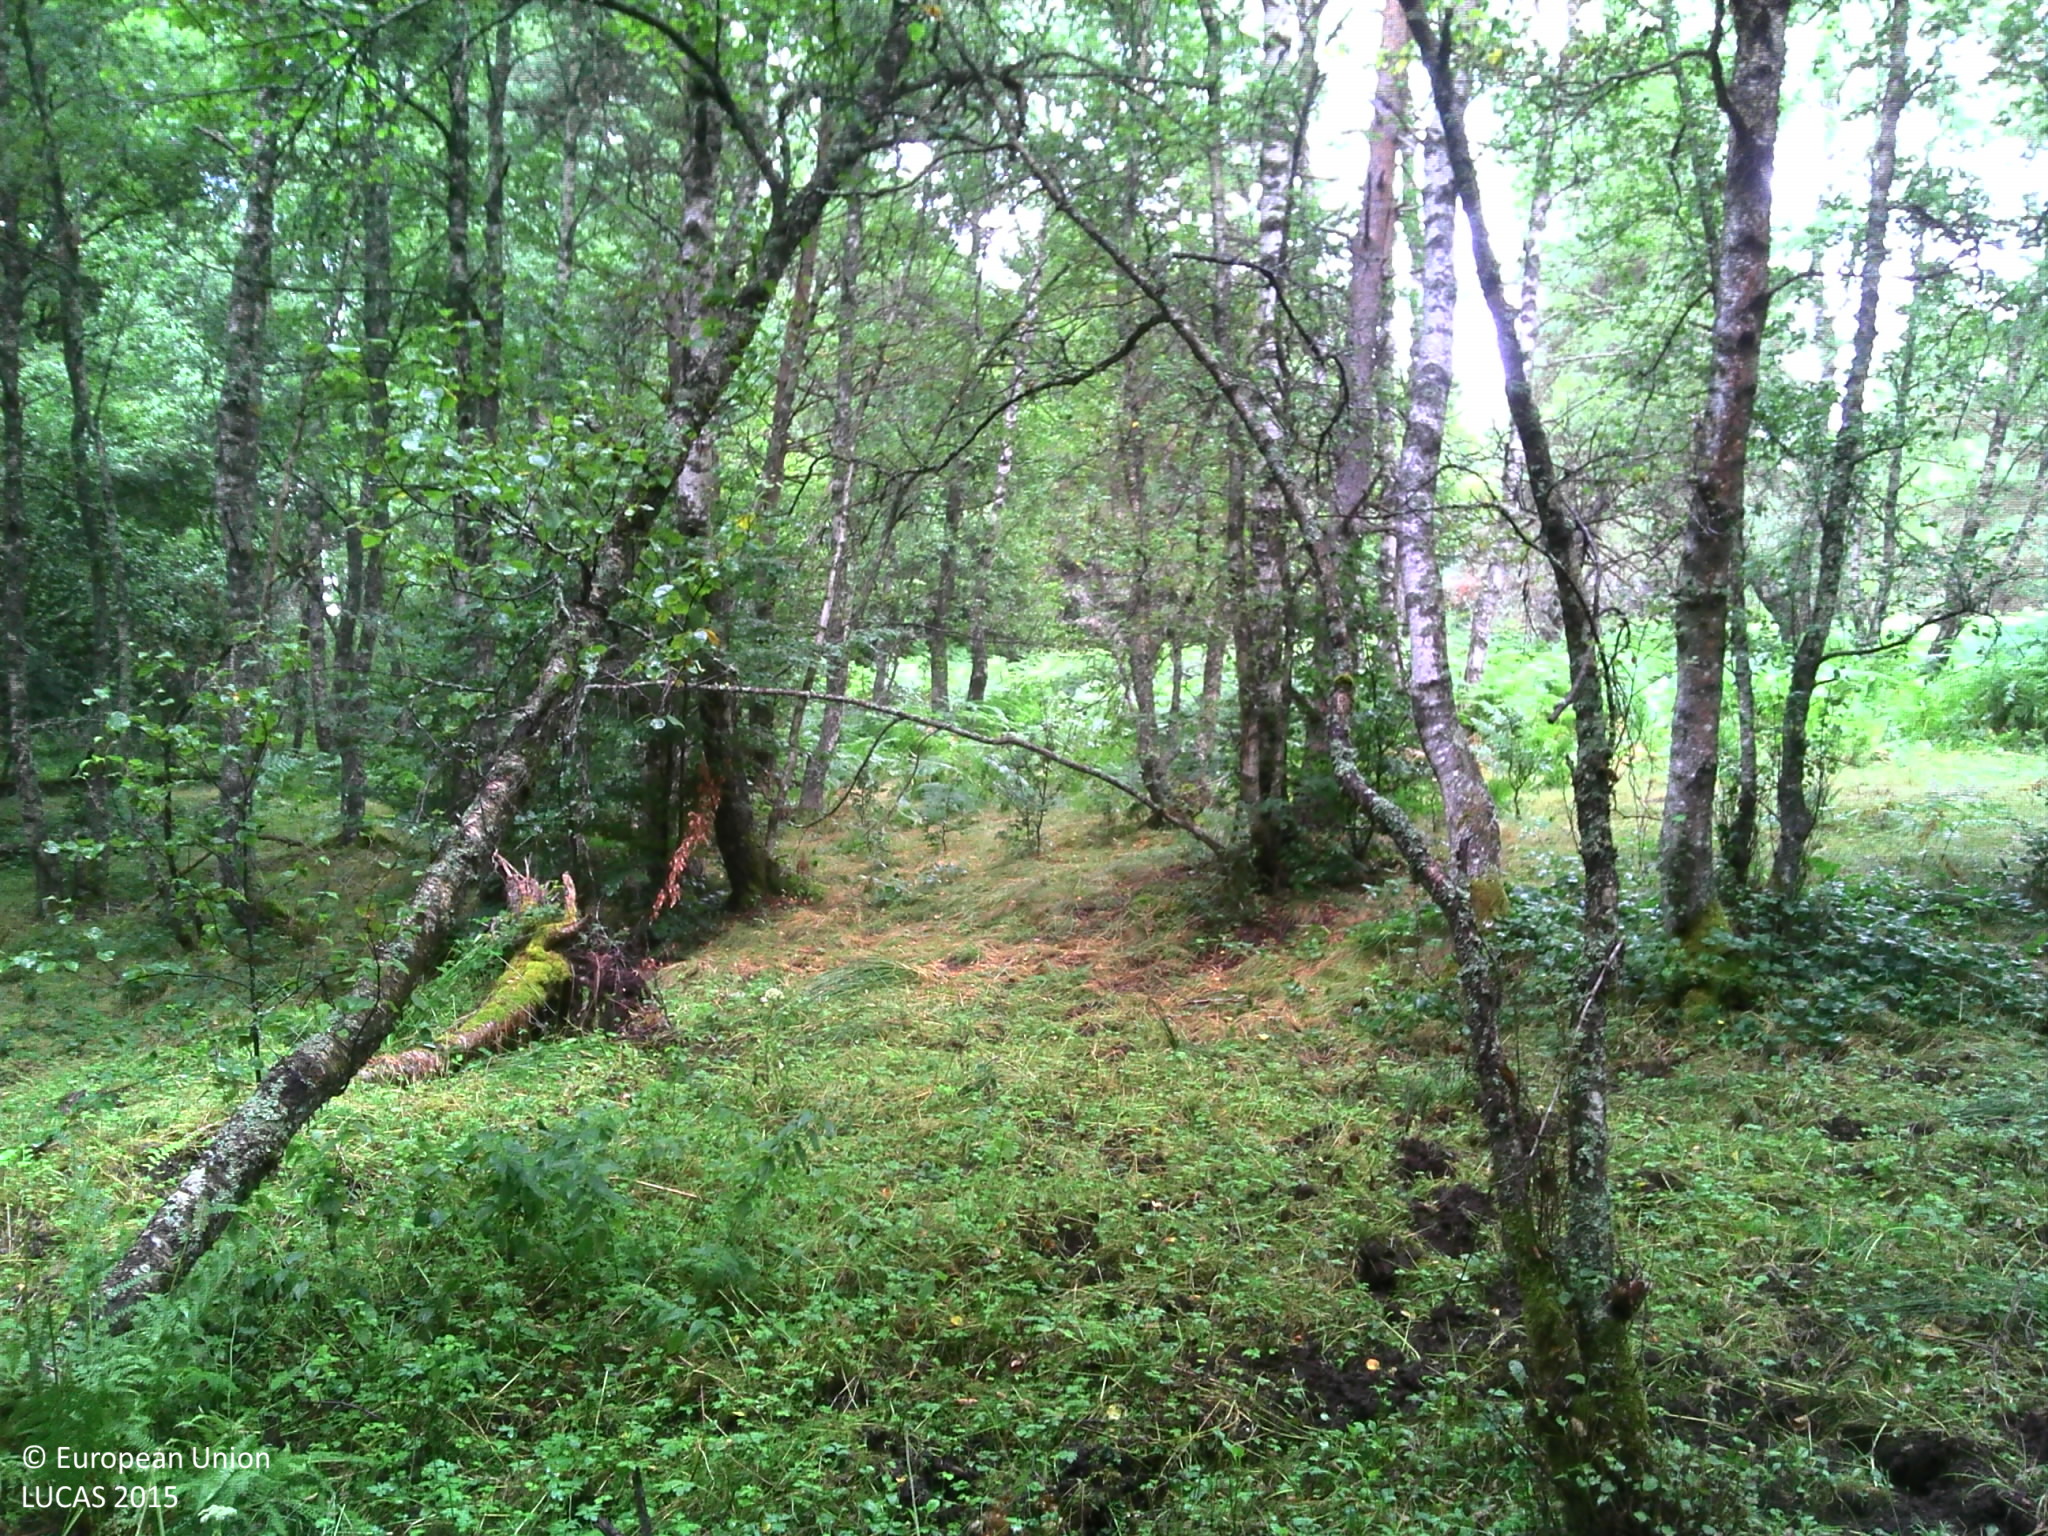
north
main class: Woodland
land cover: Broadleaved woodland
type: non-riverine alder, birch or aspen forest
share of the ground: > 75 %
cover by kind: broadleaved forest trees 80 %, herbaceous plants 20 %
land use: Forestry
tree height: > 5 m
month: July
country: FR
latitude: 44.8136
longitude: 2.9088
